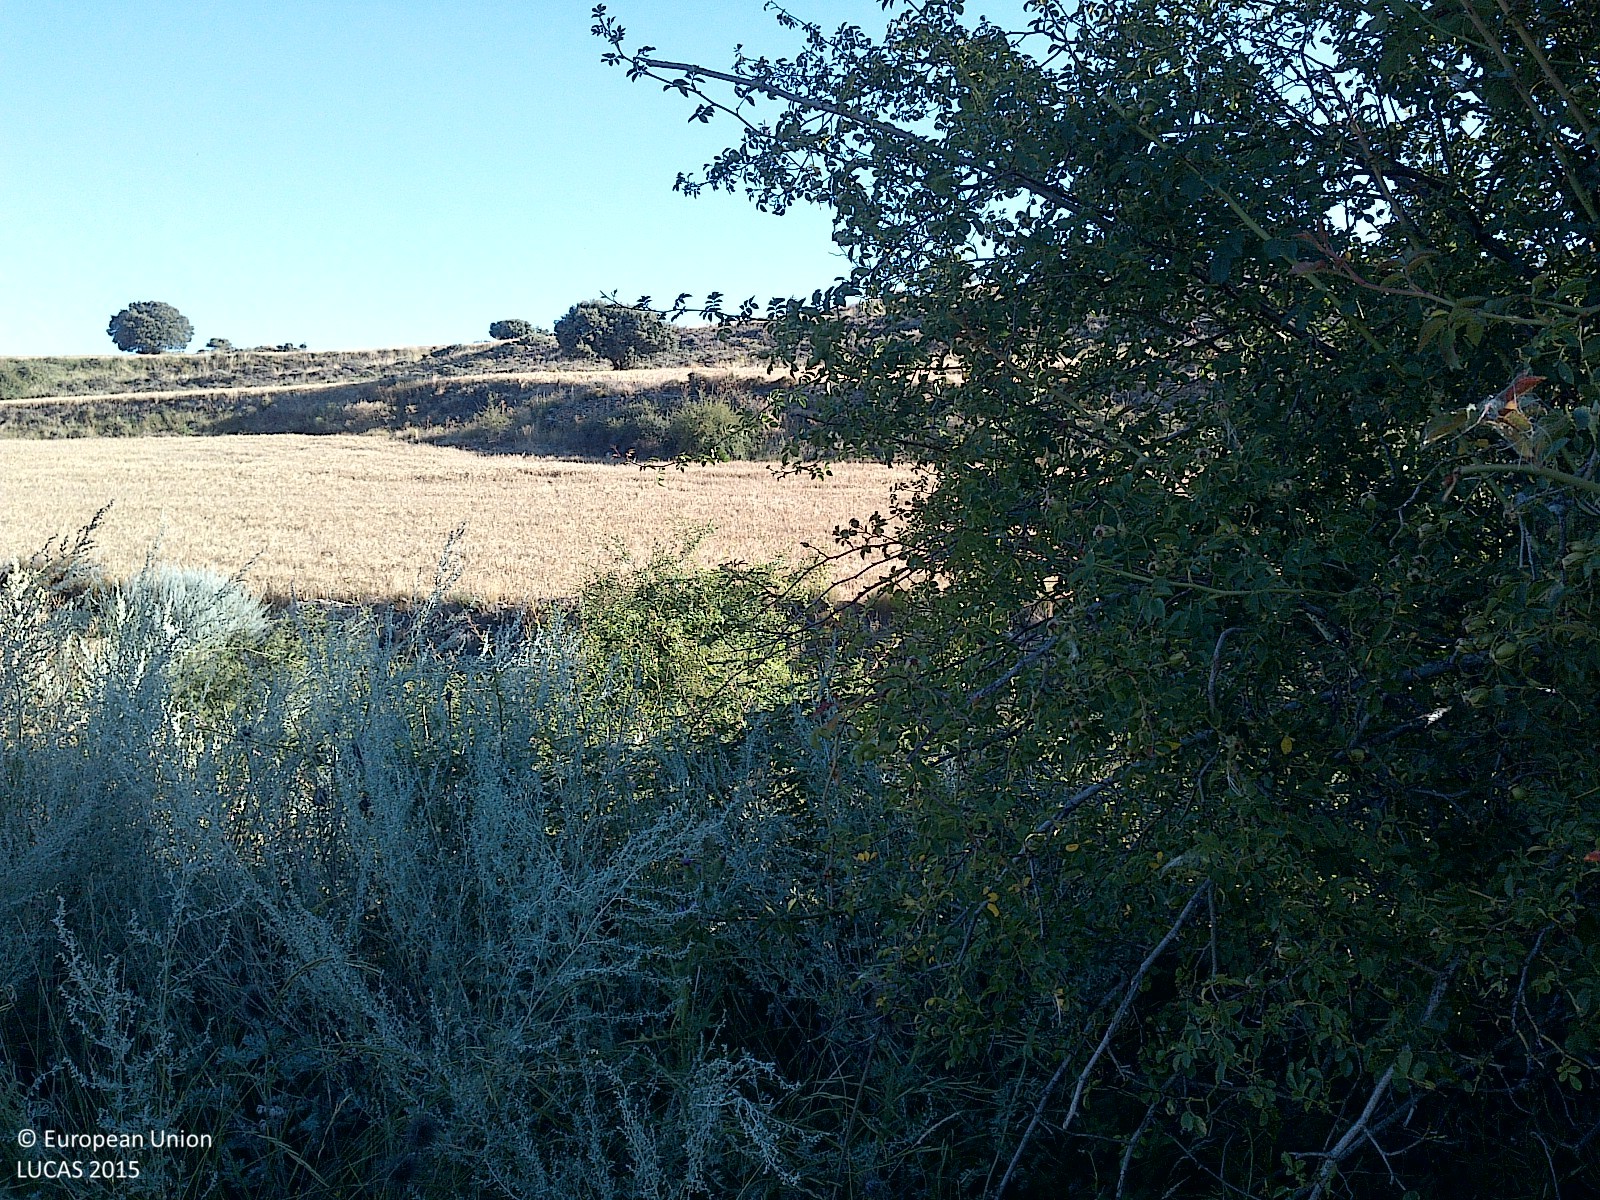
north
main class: Shrubland
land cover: Shrubland without tree cover
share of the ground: > 75 %
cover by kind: shrubs 80 %, herbaceous plants 20 %
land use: Semi-natural and natural areas not in use
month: July
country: ES
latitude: 41.8985
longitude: -2.1741
